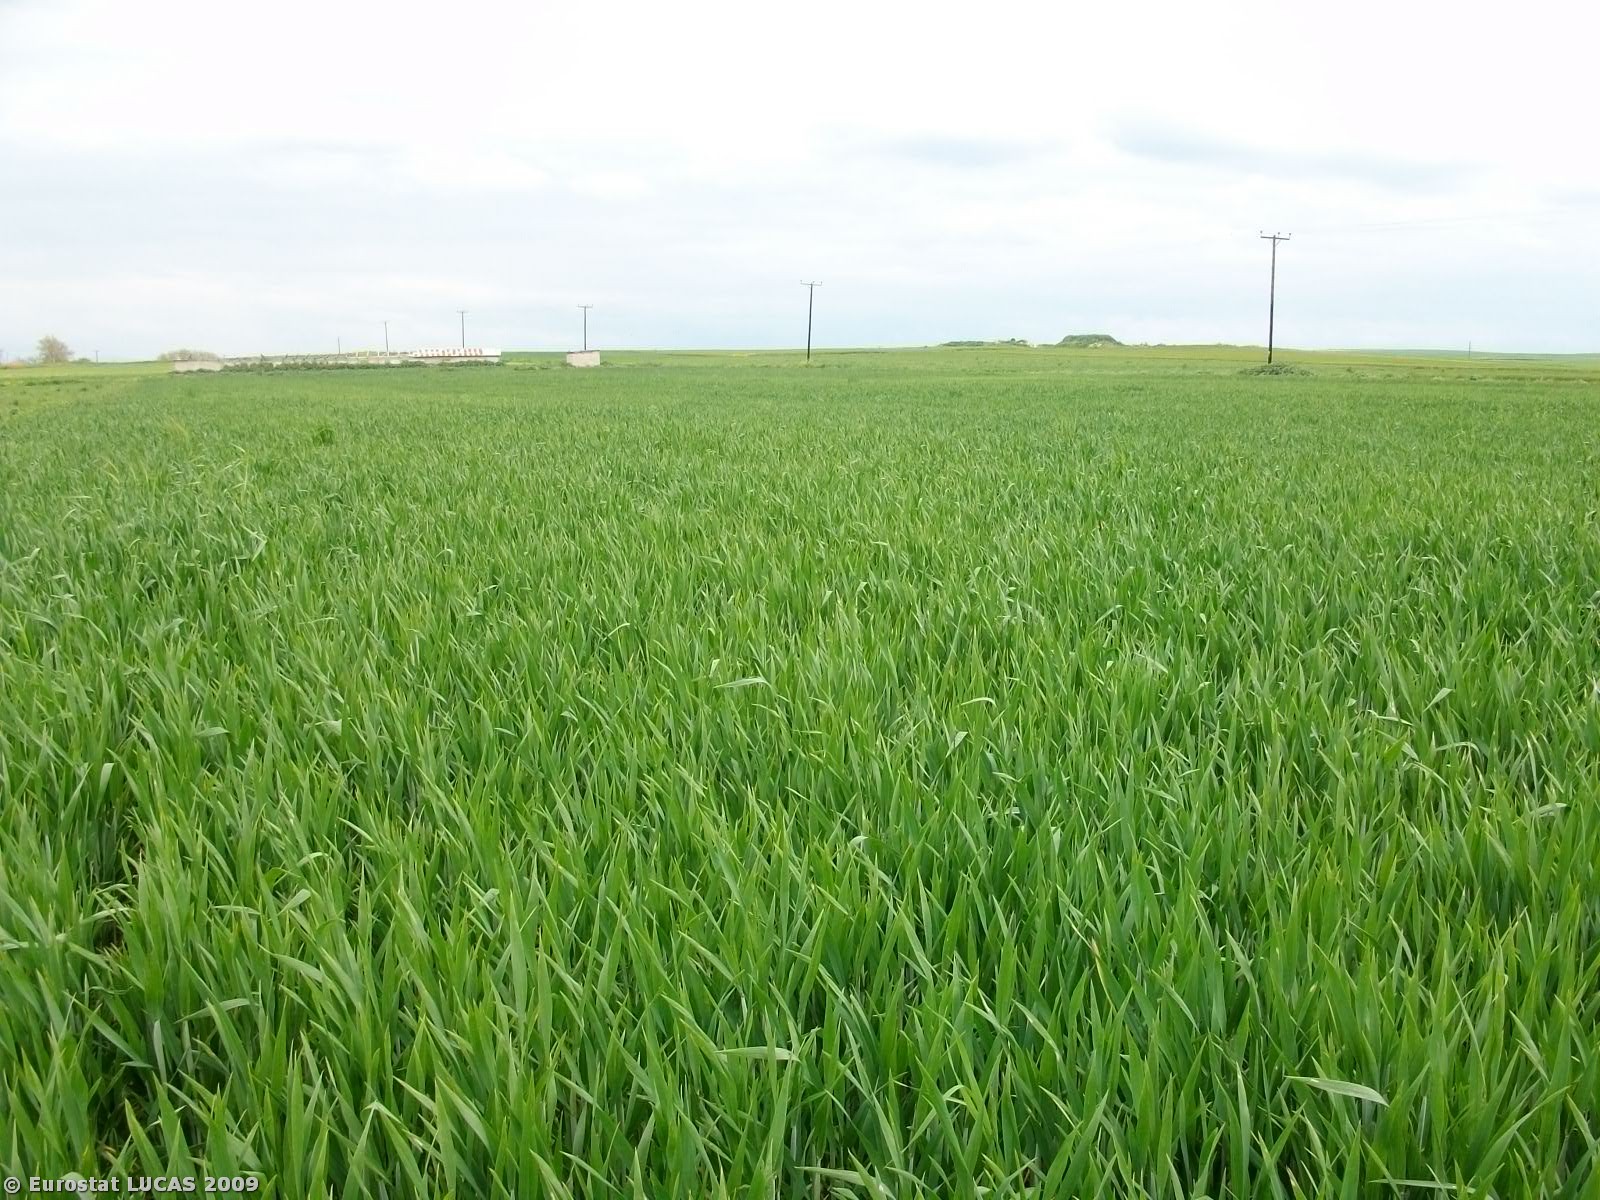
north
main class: Cropland
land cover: Durum wheat
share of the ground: > 75 %
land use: Agriculture (excluding fallow land and kitchen gardens)
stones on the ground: < 10 %
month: April
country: GR
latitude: 39.5171
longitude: 22.3758
